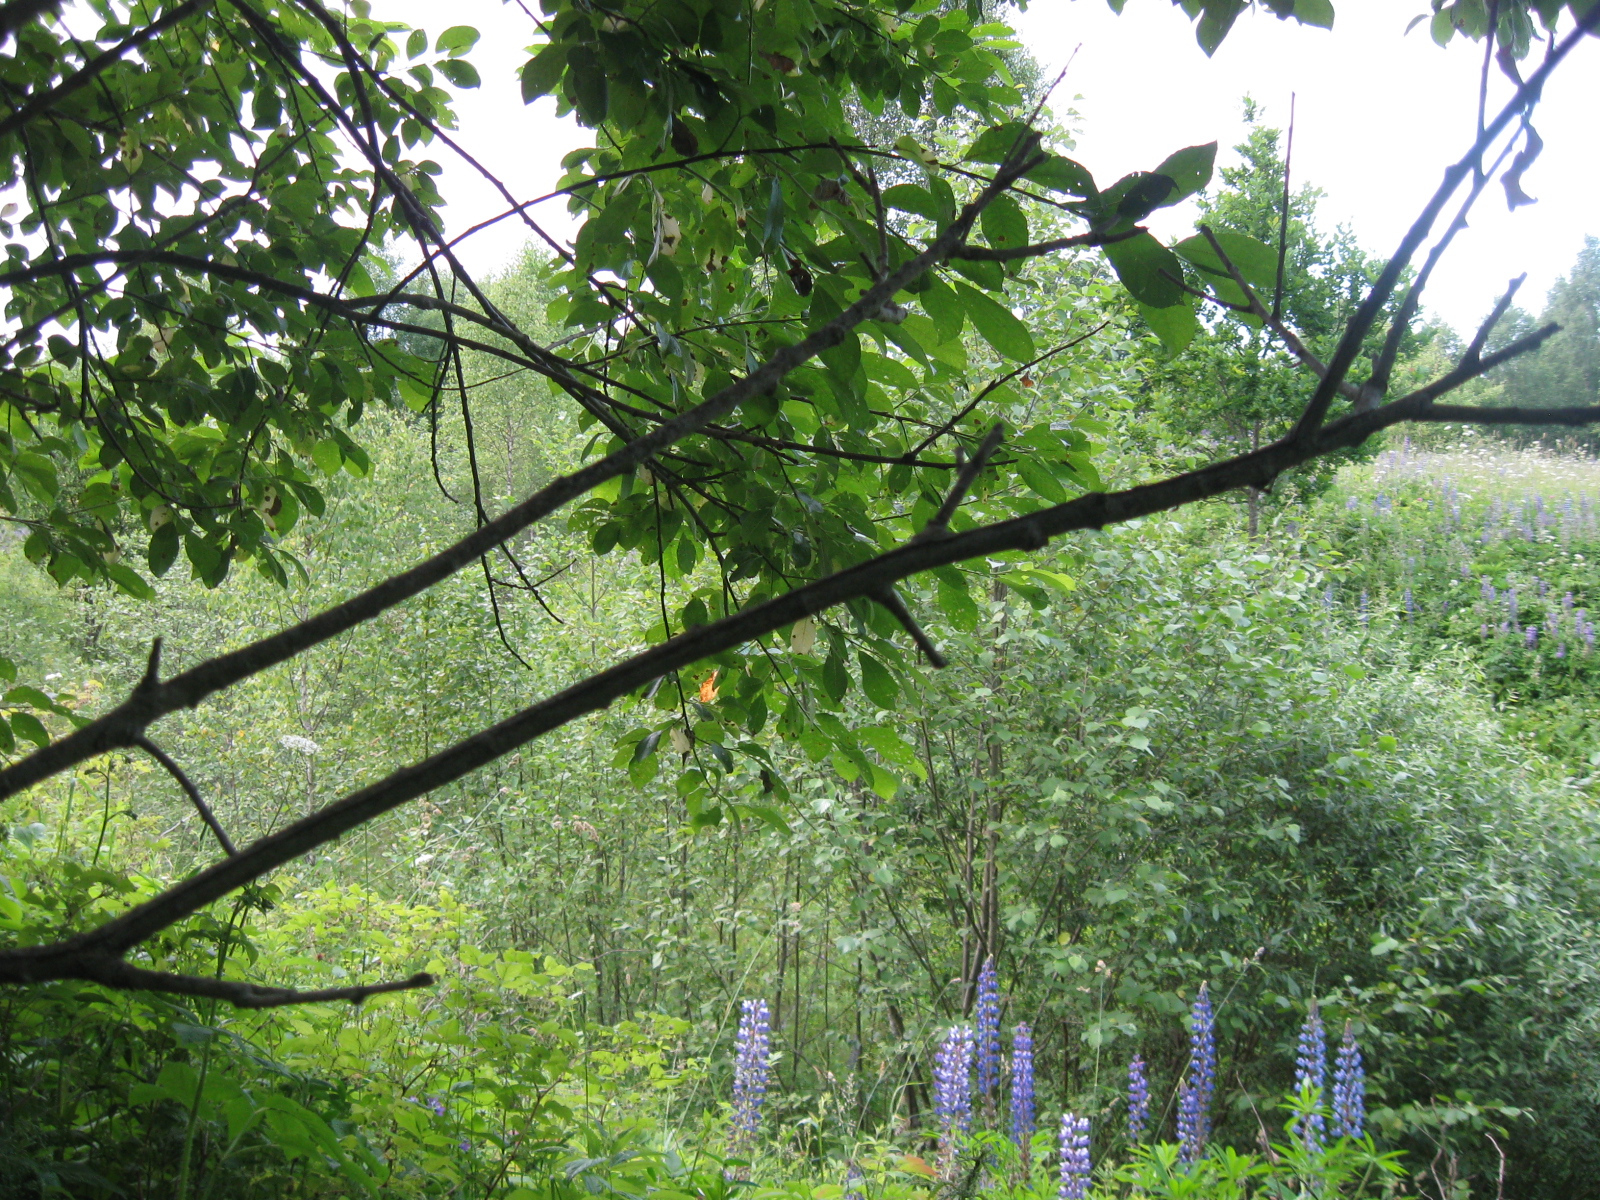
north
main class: Woodland
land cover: Broadleaved woodland
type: floodplain forest
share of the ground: 50 - 75 %
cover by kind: broadleaved forest trees 70 %, herbaceous plants 30 %
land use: Forestry
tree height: > 5 m
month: June
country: LT
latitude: 54.4334
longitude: 24.5810
